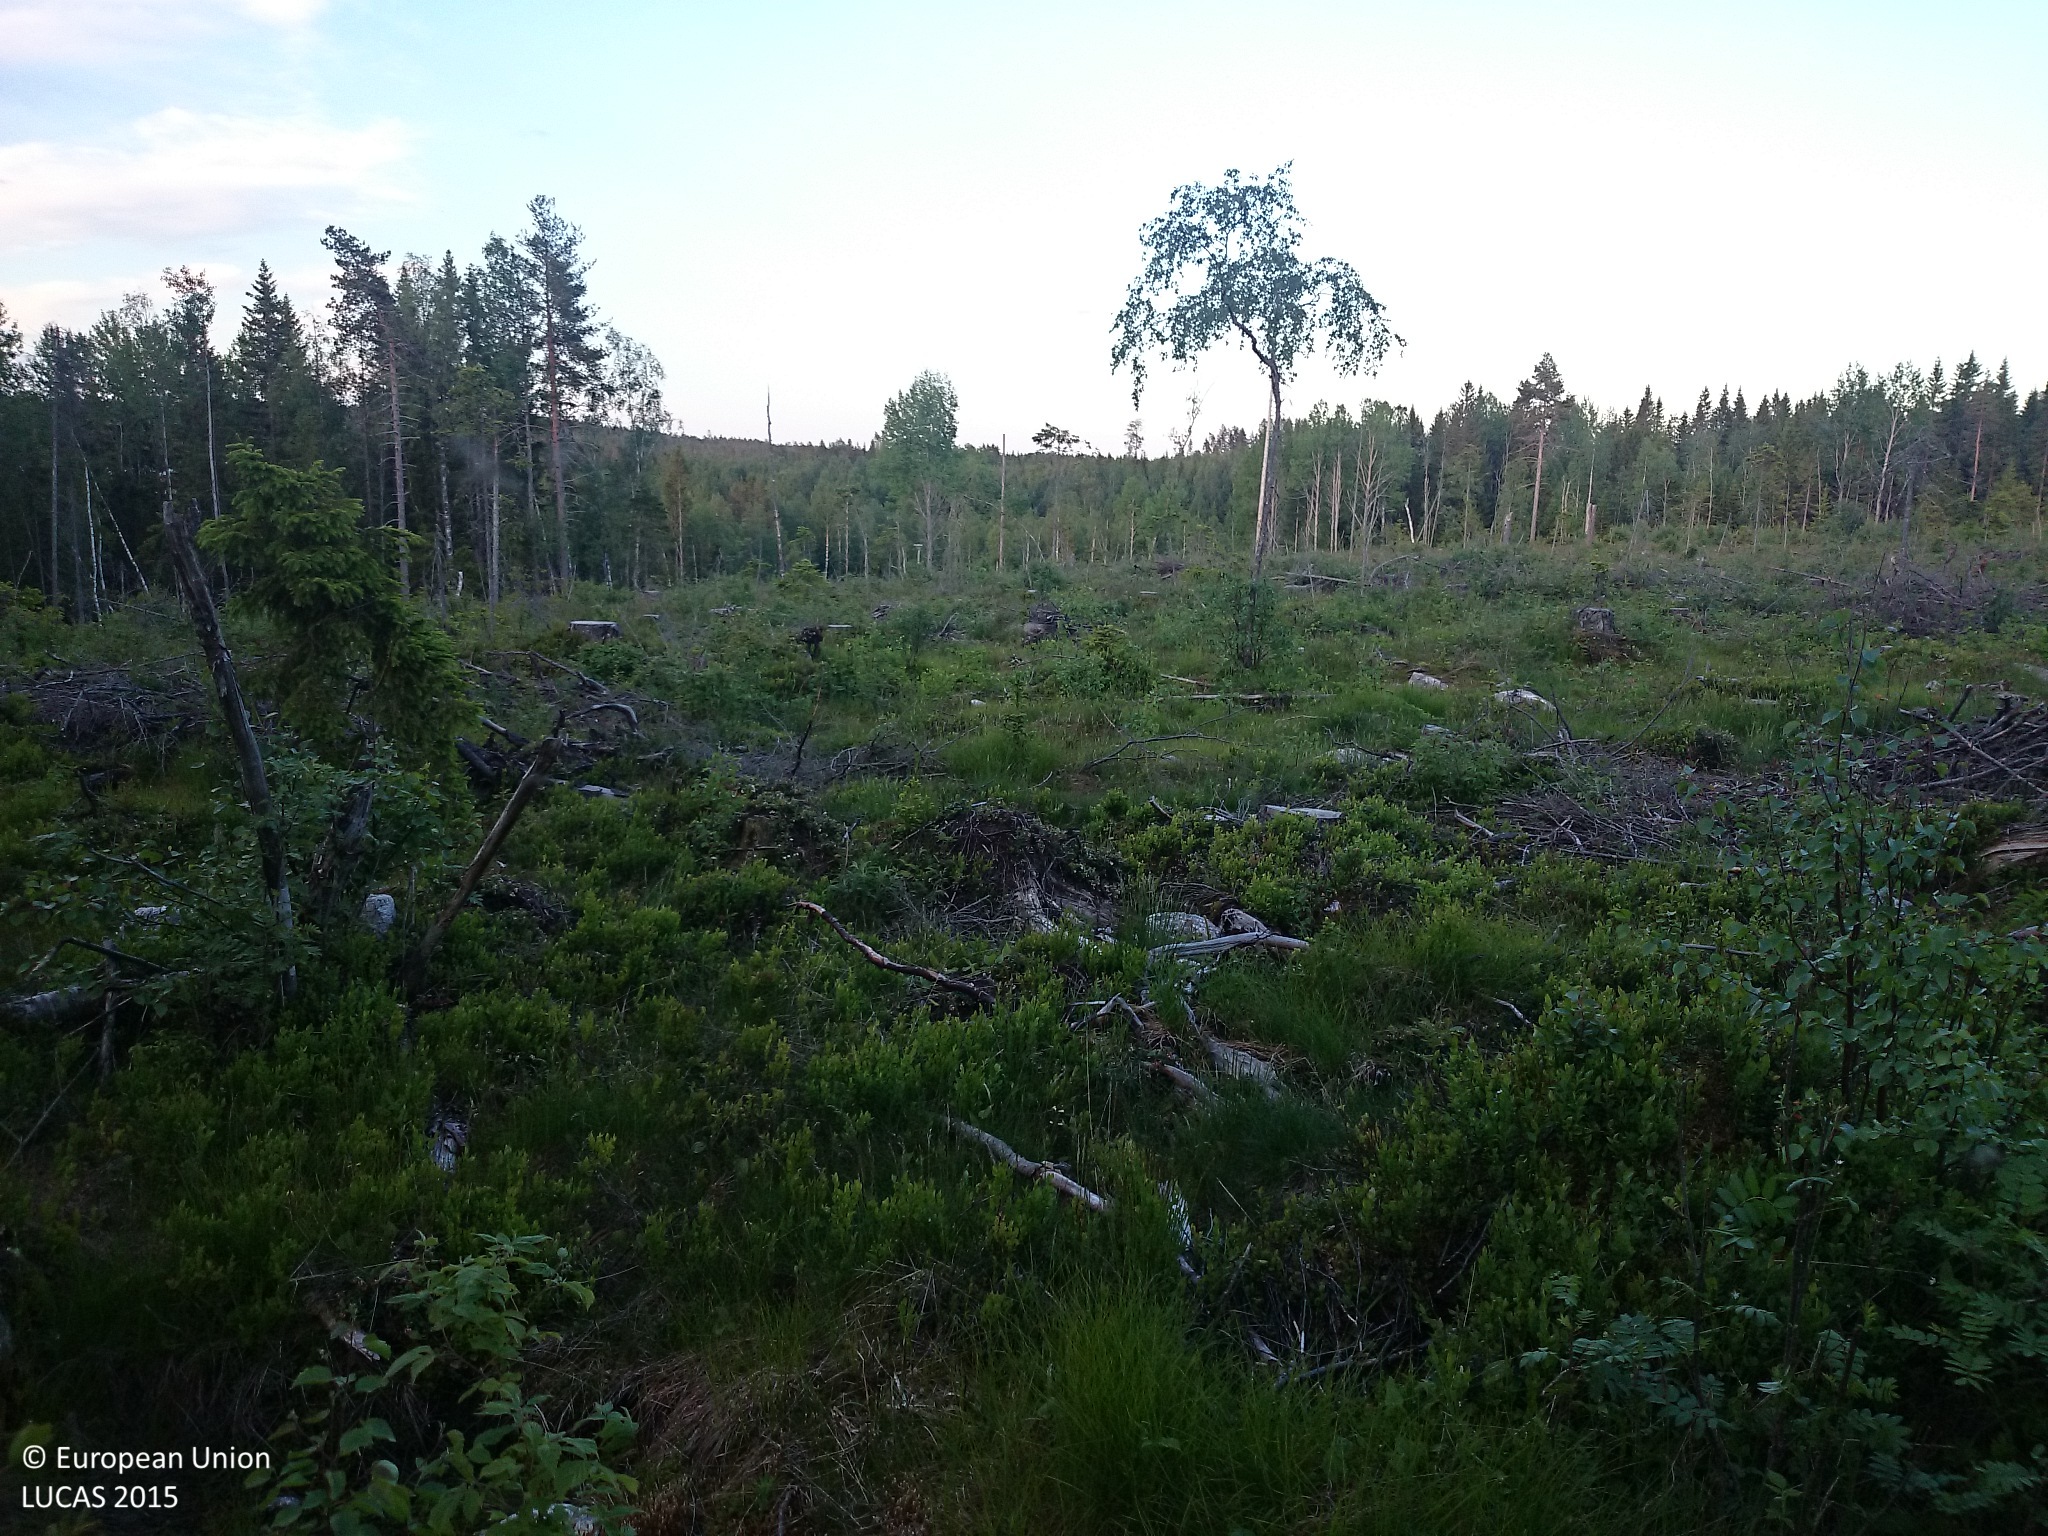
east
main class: Woodland
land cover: Broadleaved woodland
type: boreal forest
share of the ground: > 75 %
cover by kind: shrubs 45 %, herbaceous plants 40 %, broadleaved forest trees 15 %
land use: Forestry
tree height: < 5 m
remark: Clear cut
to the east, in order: Broadleaved woodland; Spruce dominated mixed woodland; Electric lines; Spruce dominated mixed woodland; Rivers and streams; Broadleaved woodland; Spruce dominated coniferous woodland; Broadleaved woodland; Rivers and streams; Broadleaved woodland; Grassland without tree/shrub cover
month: June
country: SE
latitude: 64.2855
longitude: 20.7848
